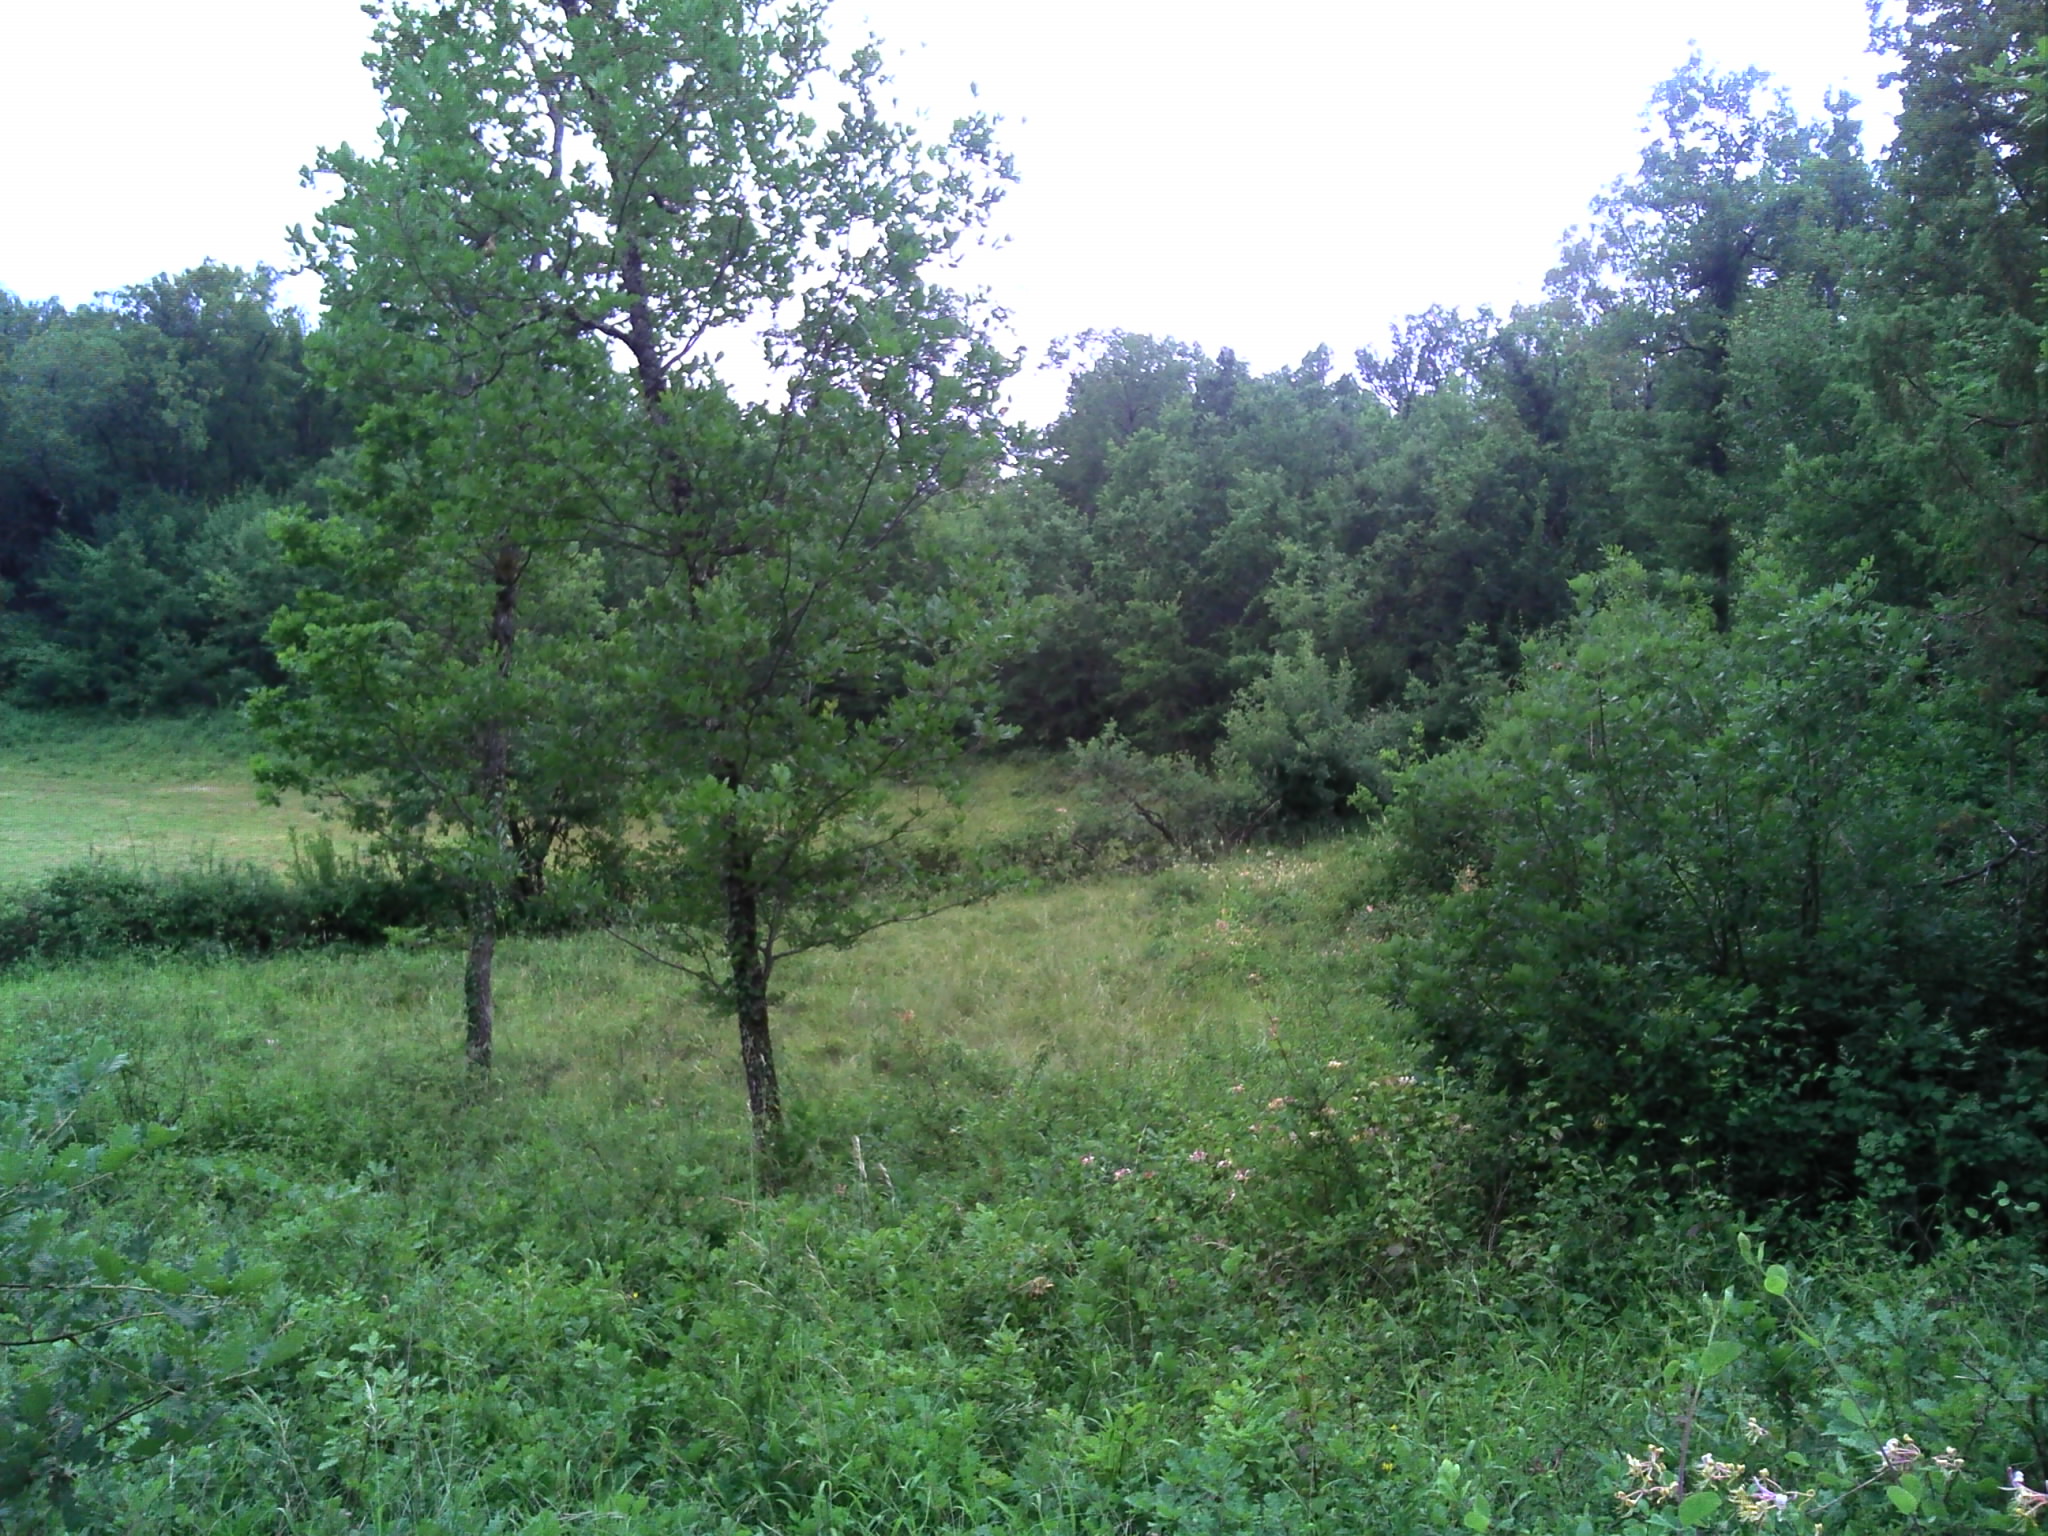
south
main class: Woodland
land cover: Broadleaved woodland
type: acidophilous oak and oak-birch forest
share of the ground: > 75 %
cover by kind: broadleaved forest trees 75 %, shrubs 20 %, herbaceous plants 5 %
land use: Forestry
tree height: > 5 m
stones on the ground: 25 - 50 %
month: June
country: FR
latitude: 44.4082
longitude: 1.8254
